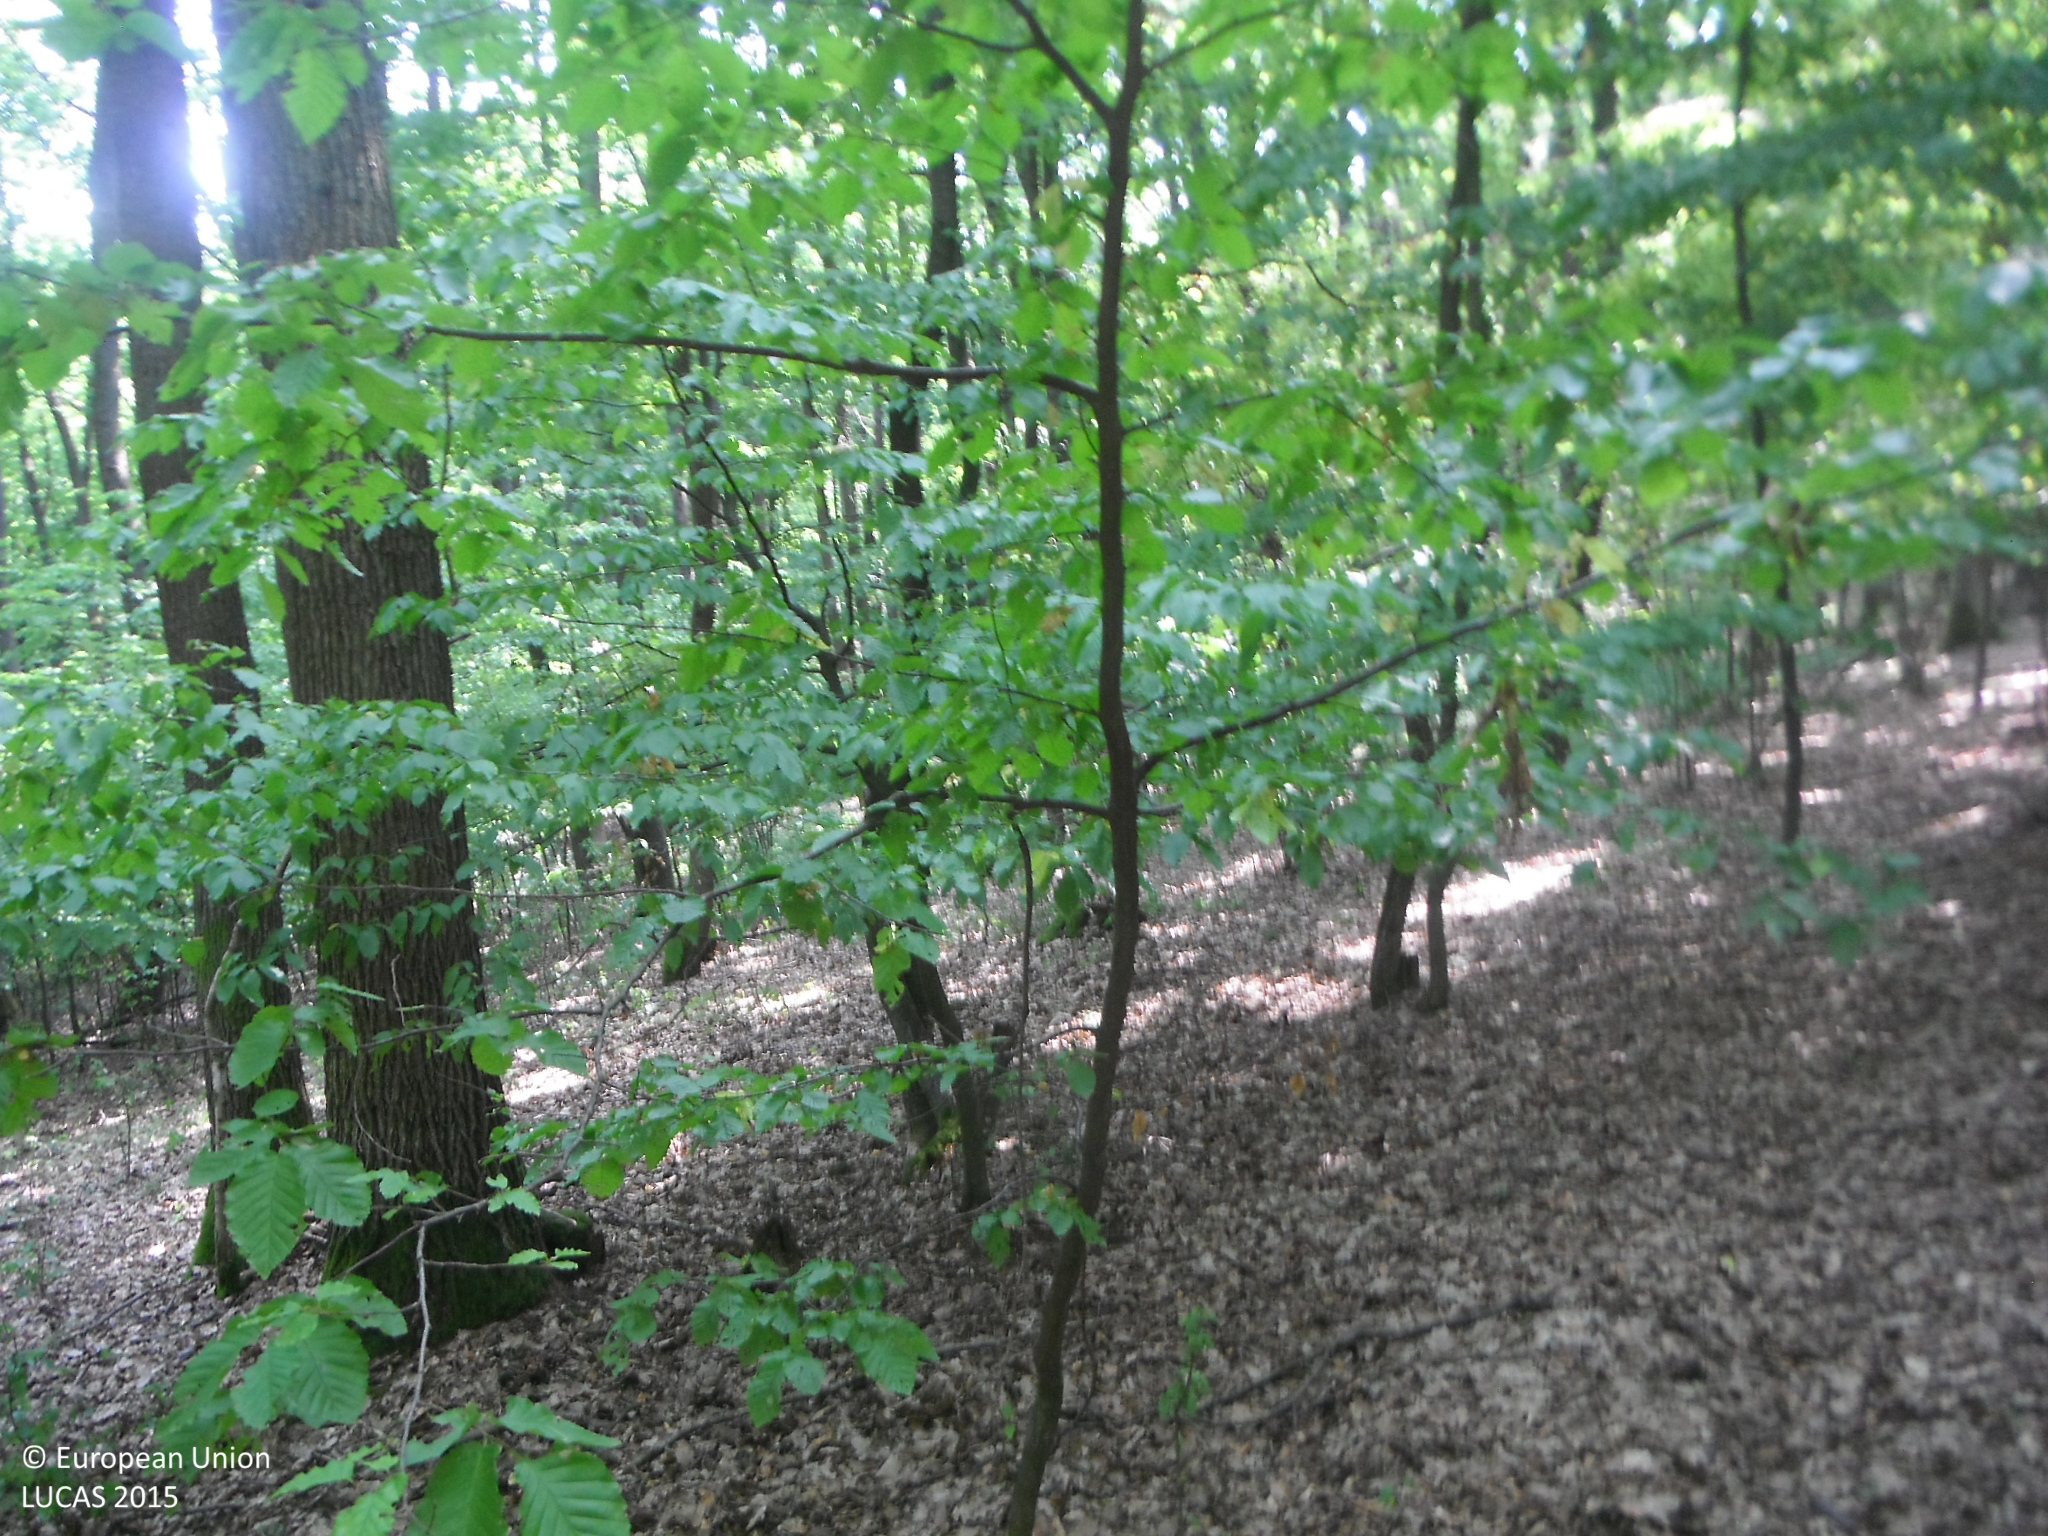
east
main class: Woodland
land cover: Broadleaved woodland
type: acidophilous oak and oak-birch forest
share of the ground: > 75 %
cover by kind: broadleaved forest trees 95 %, shrubs 5 %
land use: Forestry
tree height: > 5 m
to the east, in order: Broadleaved woodland; Tracks; Broadleaved woodland; Tracks; Broadleaved woodland
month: August
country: SK
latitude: 48.7166
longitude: 18.1564
